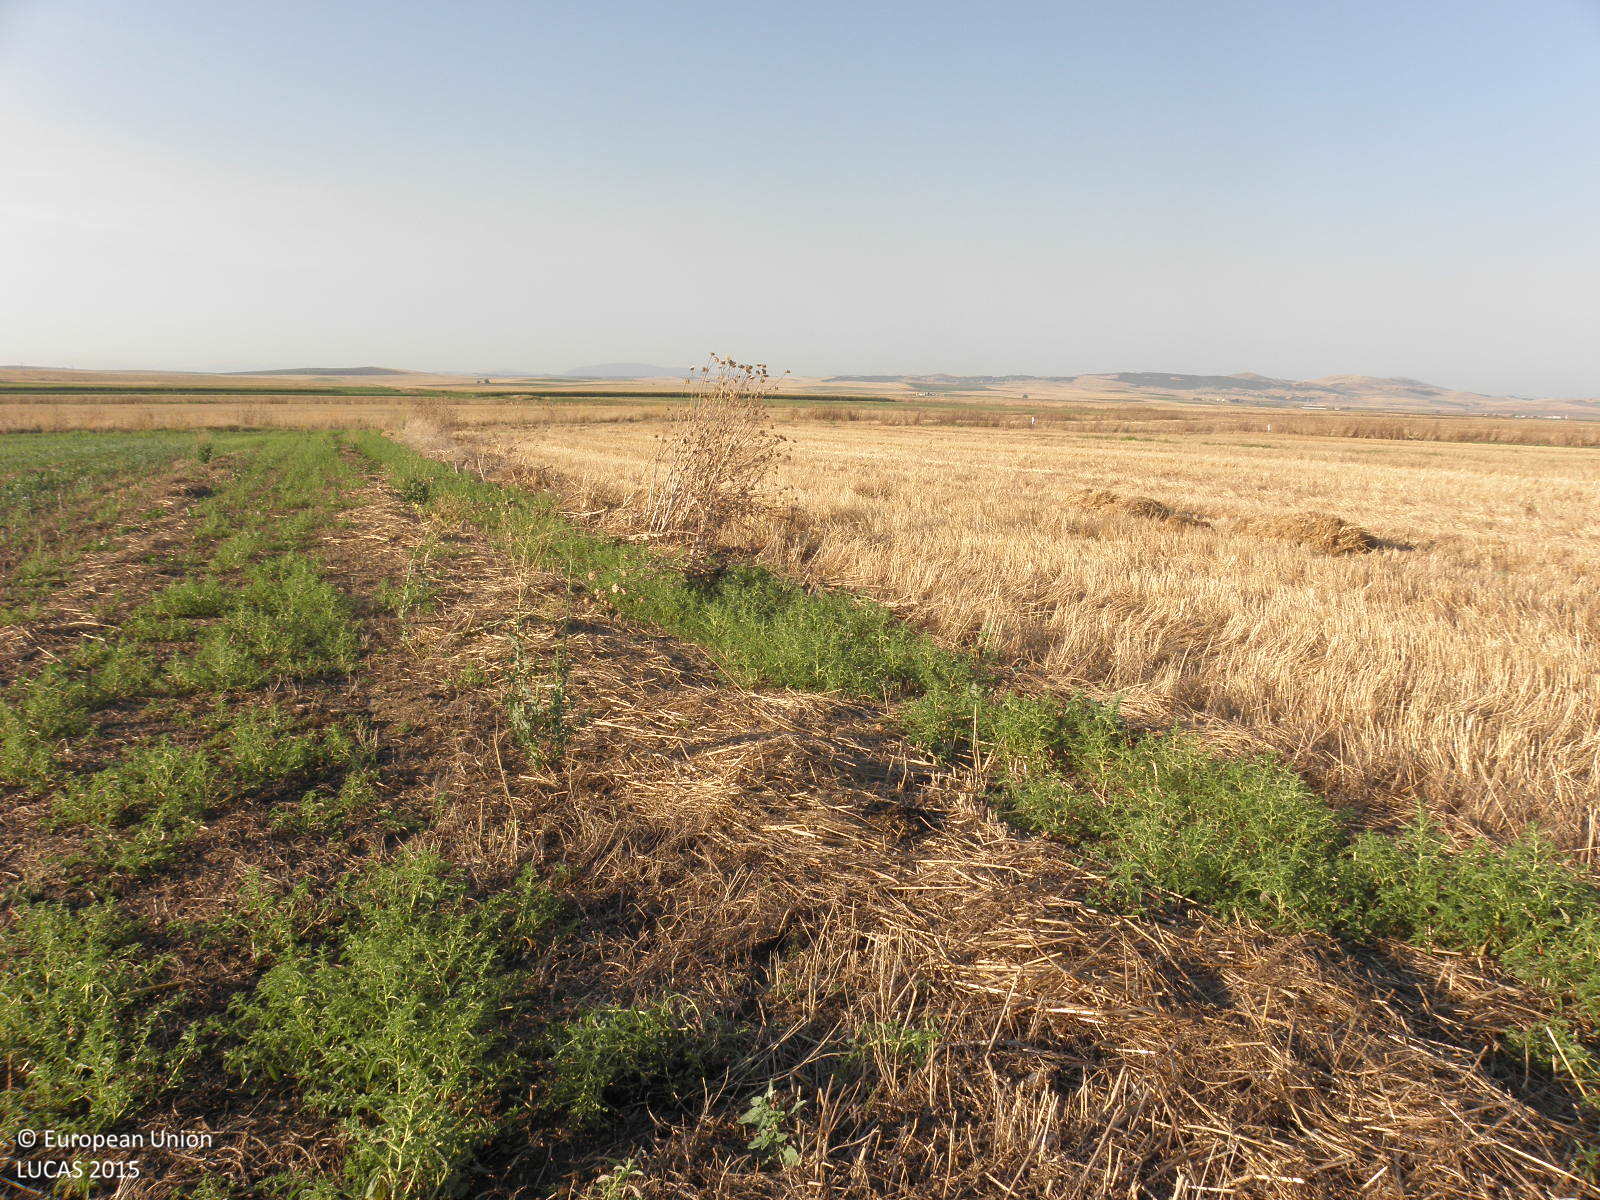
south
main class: Grassland
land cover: Spontaneously vegetated surfaces
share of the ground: 50 - 75 %
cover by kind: herbaceous plants 60 %, consolidated bare surface 40 %
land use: Agriculture (excluding fallow land and kitchen gardens)
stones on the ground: < 10 %
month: July
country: GR
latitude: 39.5171
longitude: 22.3758
